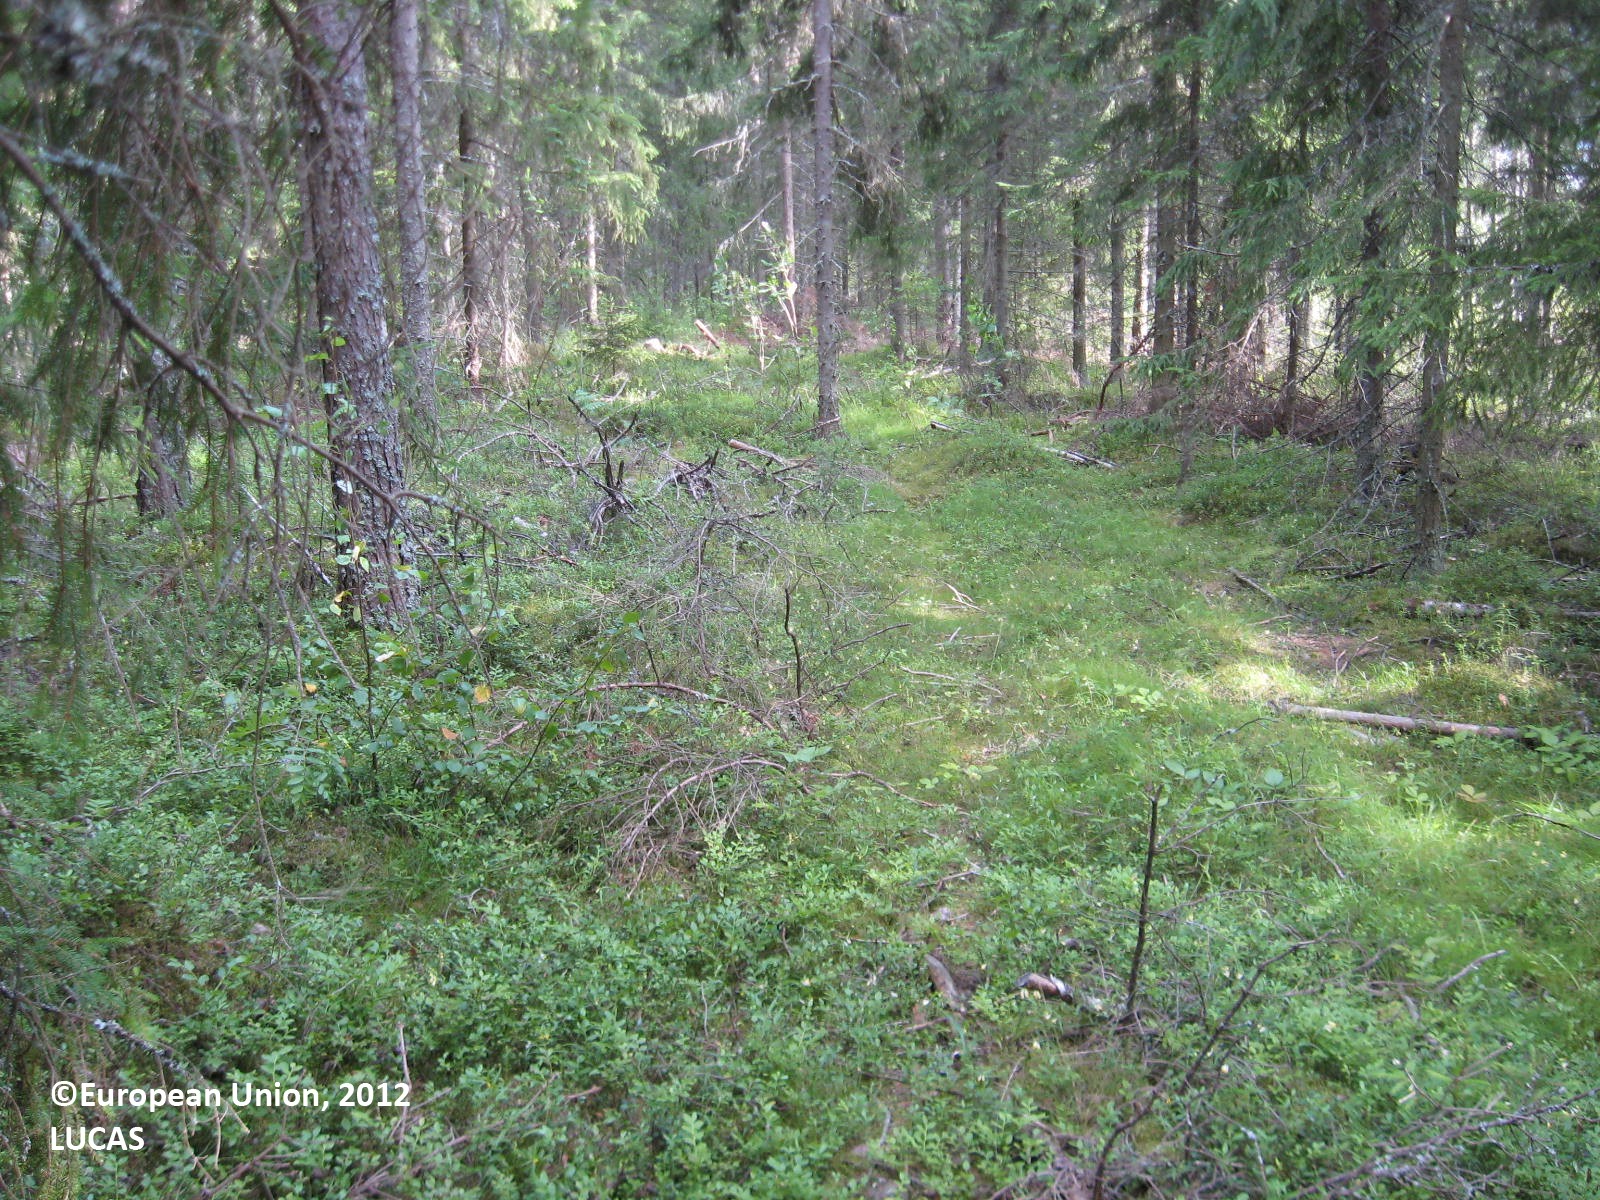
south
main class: Woodland
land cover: Spruce dominated coniferous woodland
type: boreal forest
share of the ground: > 75 %
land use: Forestry
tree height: > 5 m
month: July
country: FI
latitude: 62.0396
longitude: 21.5374
